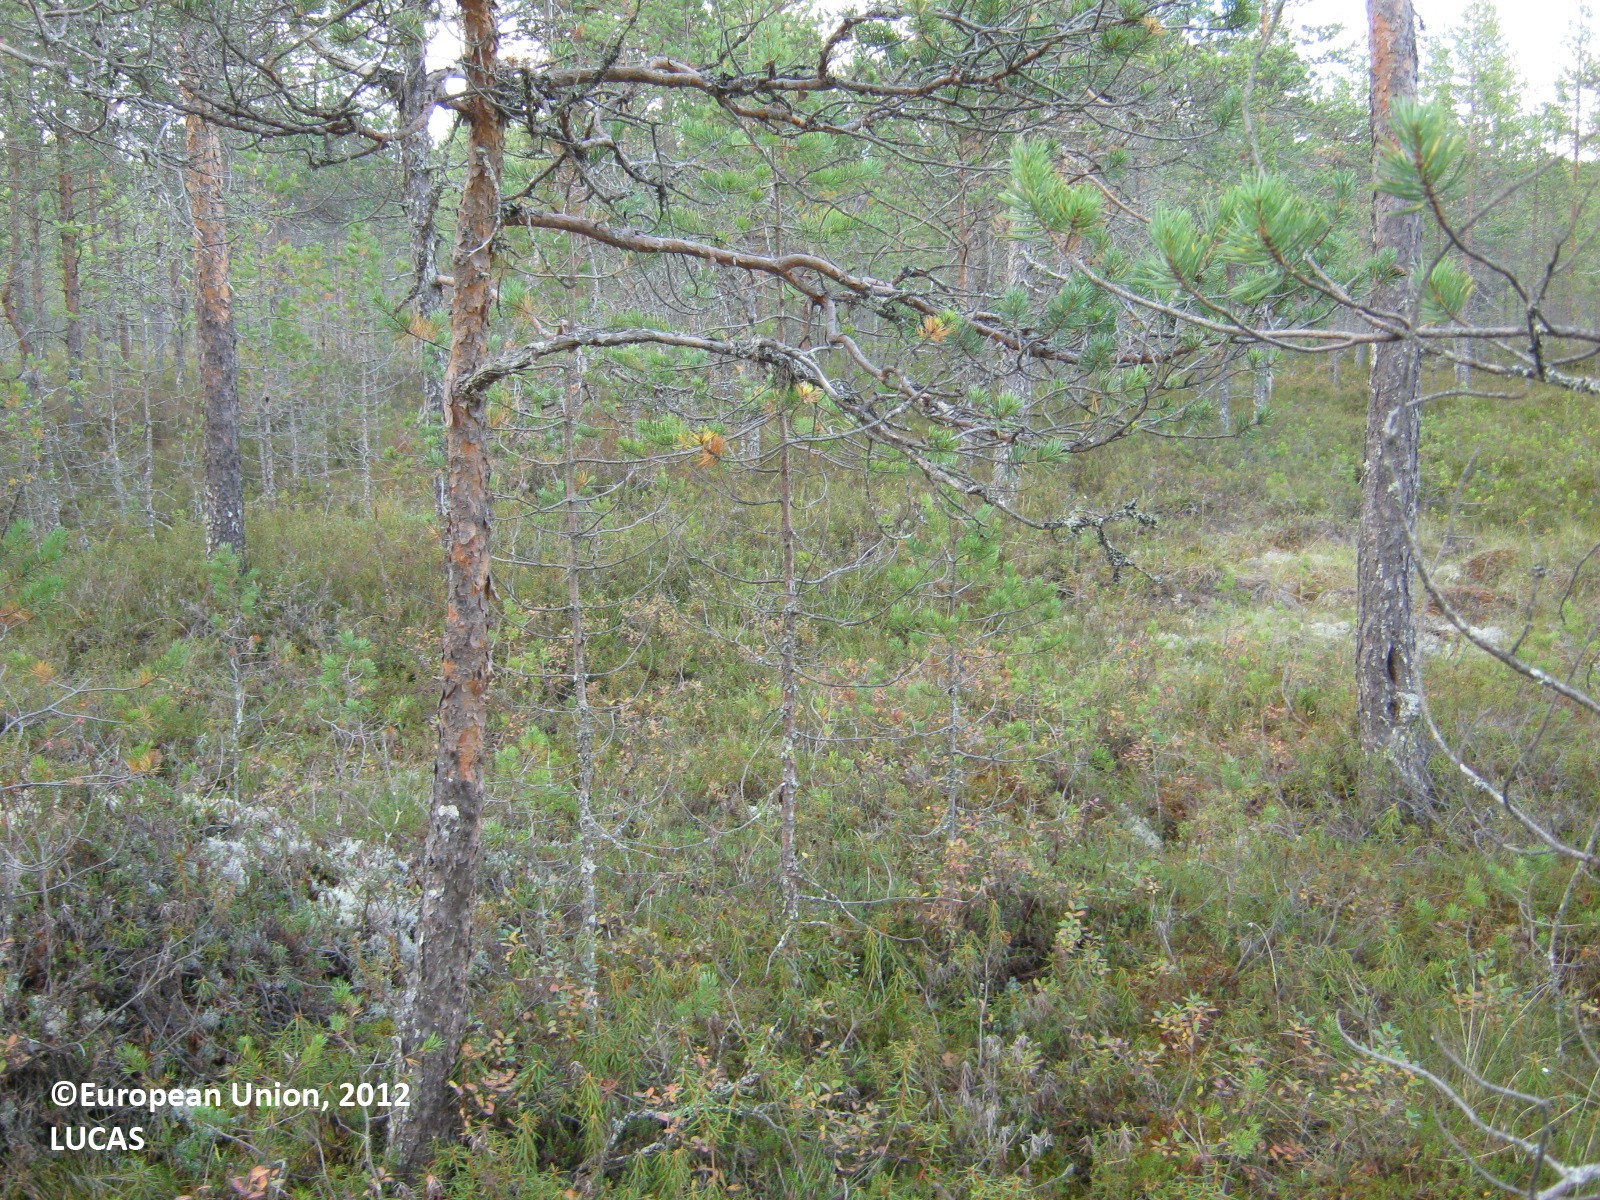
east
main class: Woodland
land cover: Pine dominated coniferous woodland
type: boreal forest
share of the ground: > 75 %
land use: Forestry
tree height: > 5 m
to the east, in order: Pine dominated coniferous woodland; Ditches and canals; Pine dominated coniferous woodland; Ditches and canals; Pine dominated coniferous woodland; Ditches and canals; Spruce dominated mixed woodland; Grass margins; Tracks
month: September
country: FI
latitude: 63.4635
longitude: 25.8593
